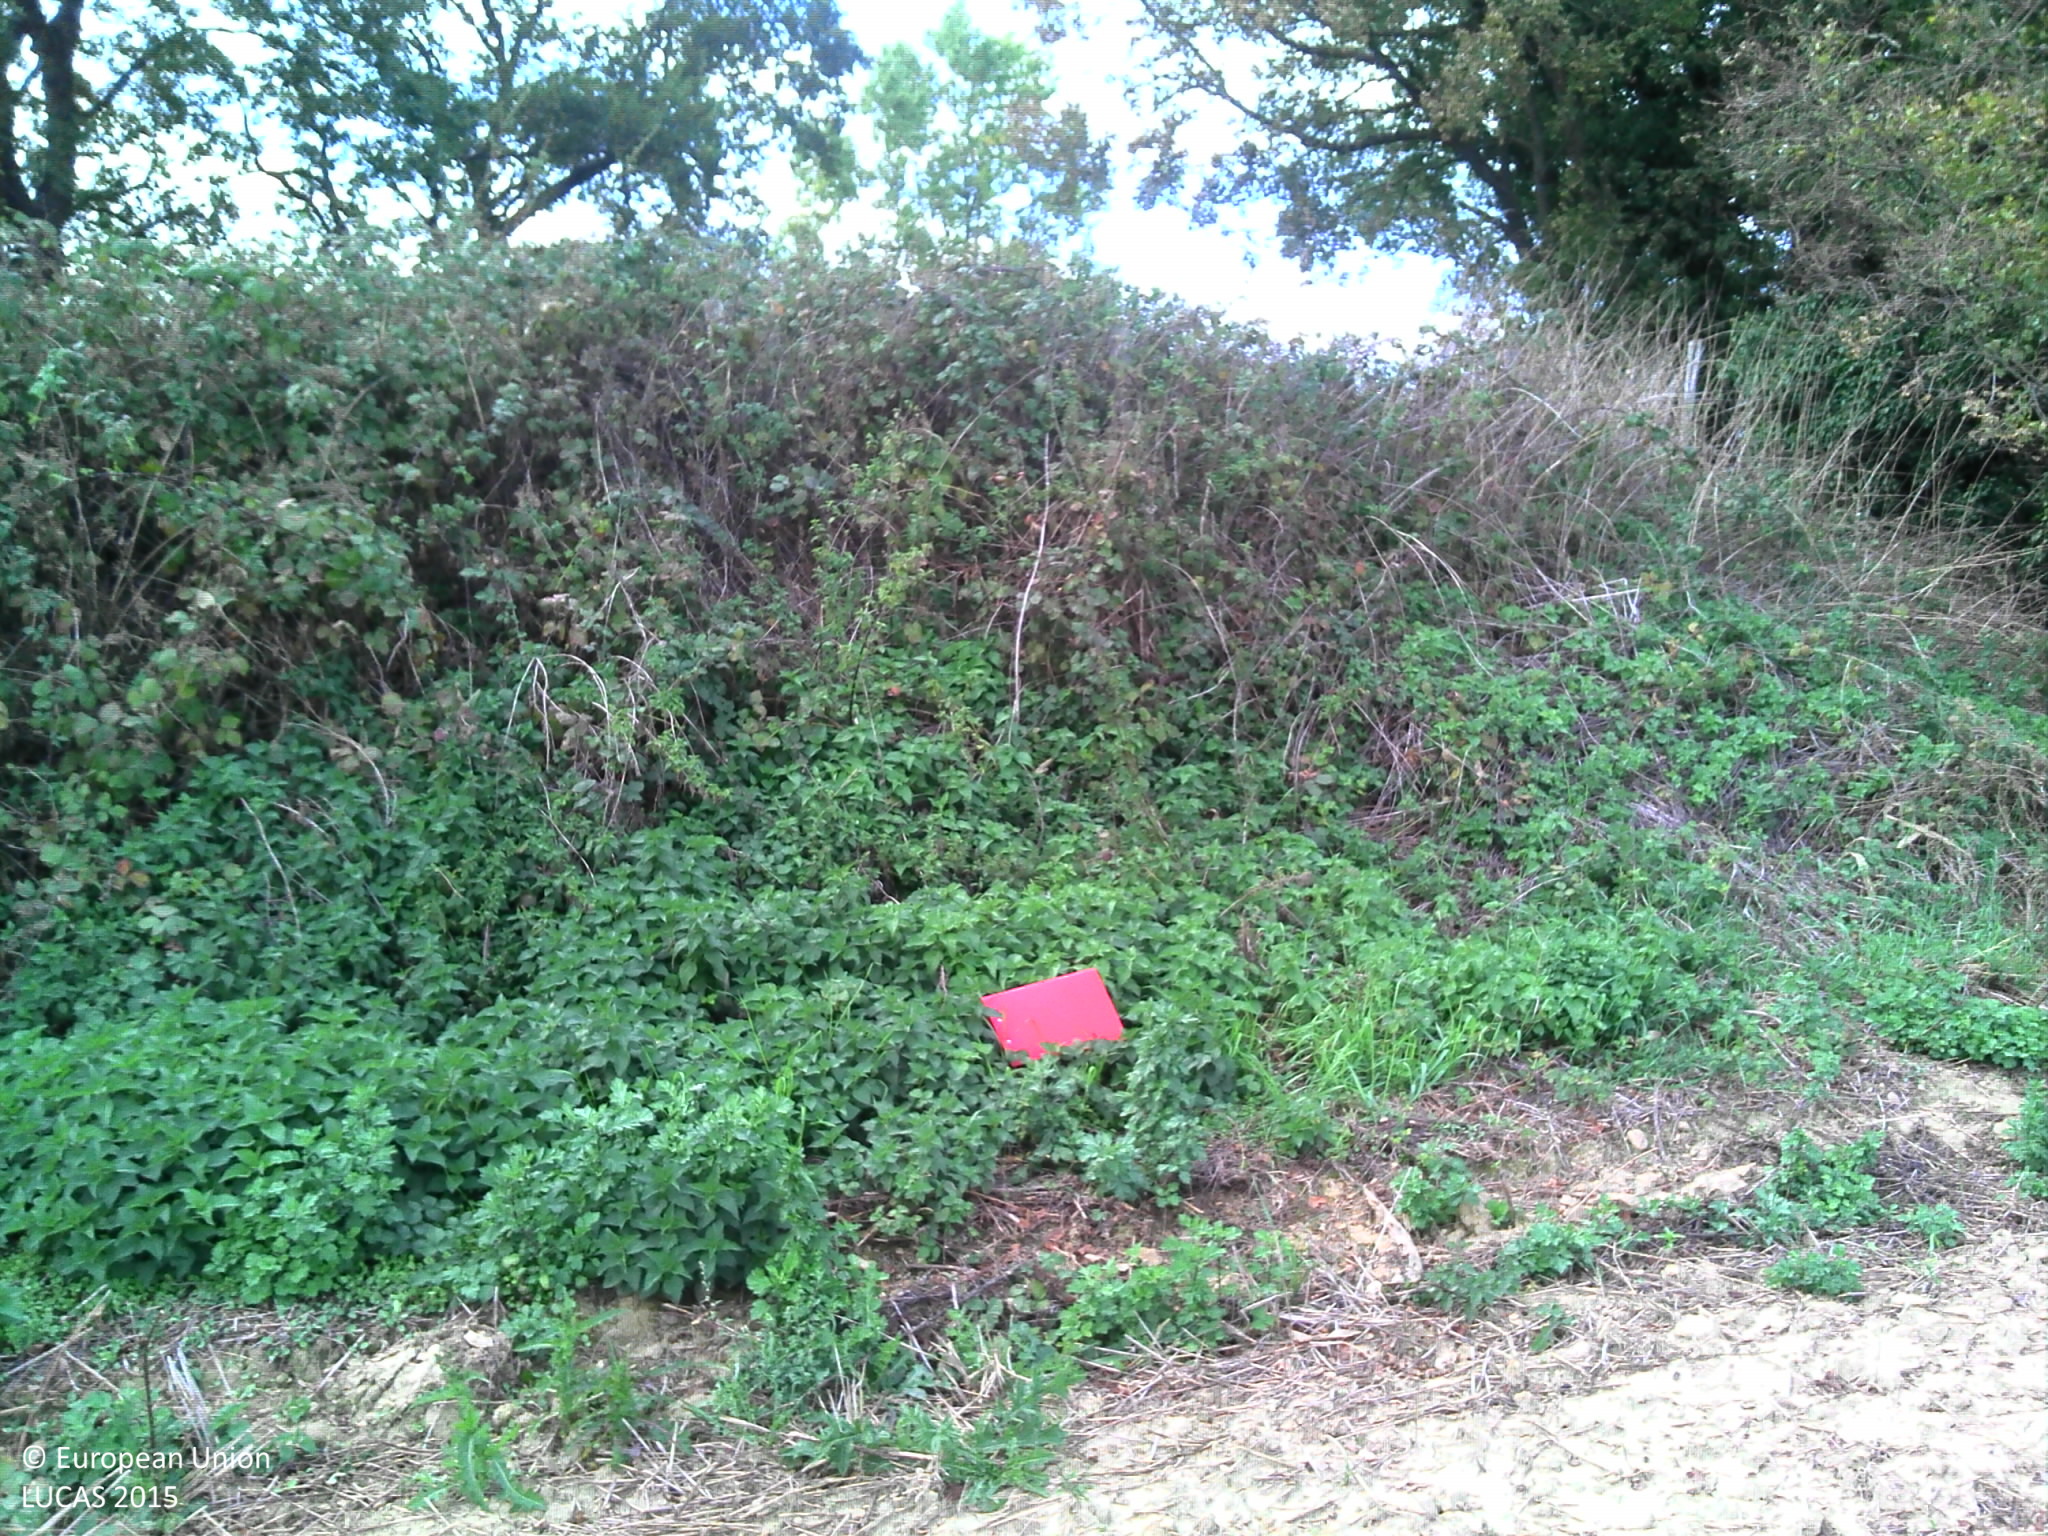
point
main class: Cropland
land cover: Common wheat
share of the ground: > 75 %
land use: Agriculture (excluding fallow land and kitchen gardens)
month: October
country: FR
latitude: 45.9387
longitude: 4.8568
